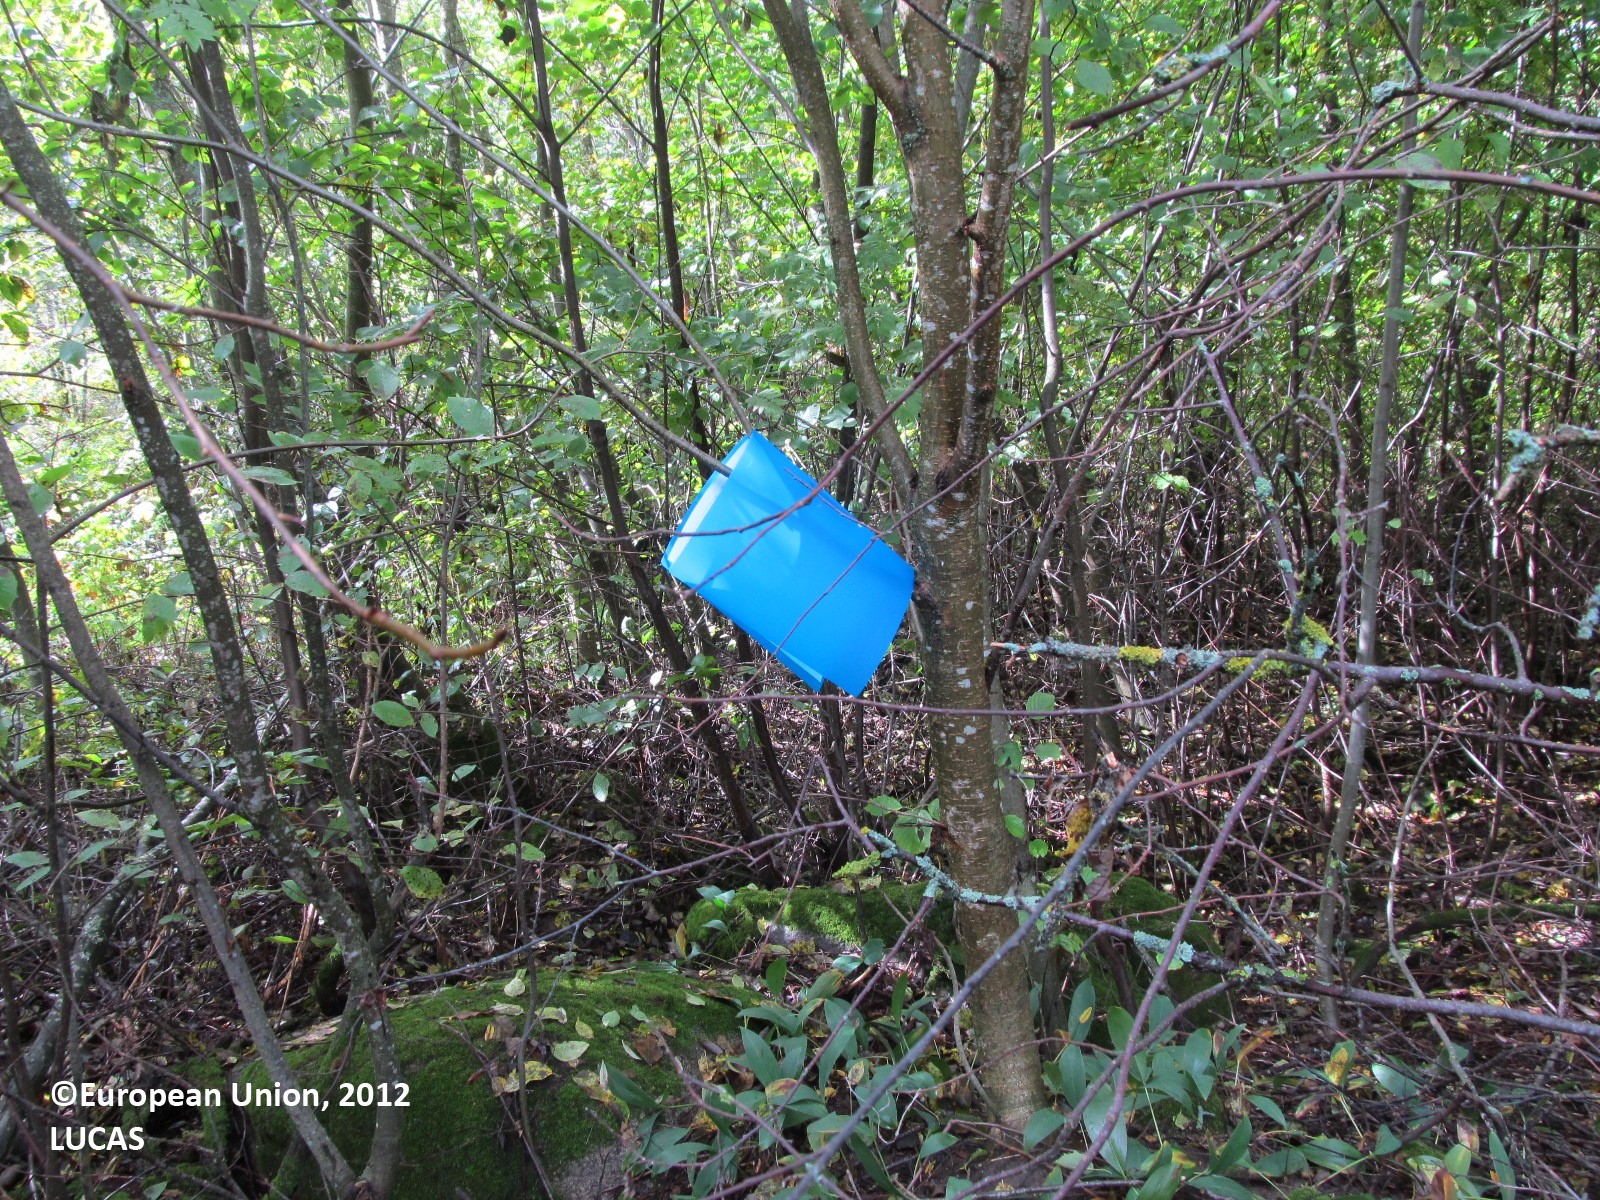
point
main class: Woodland
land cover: Broadleaved woodland
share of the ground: > 75 %
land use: Semi-natural and natural areas not in use
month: September
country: FI
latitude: 62.8857
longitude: 28.1806
